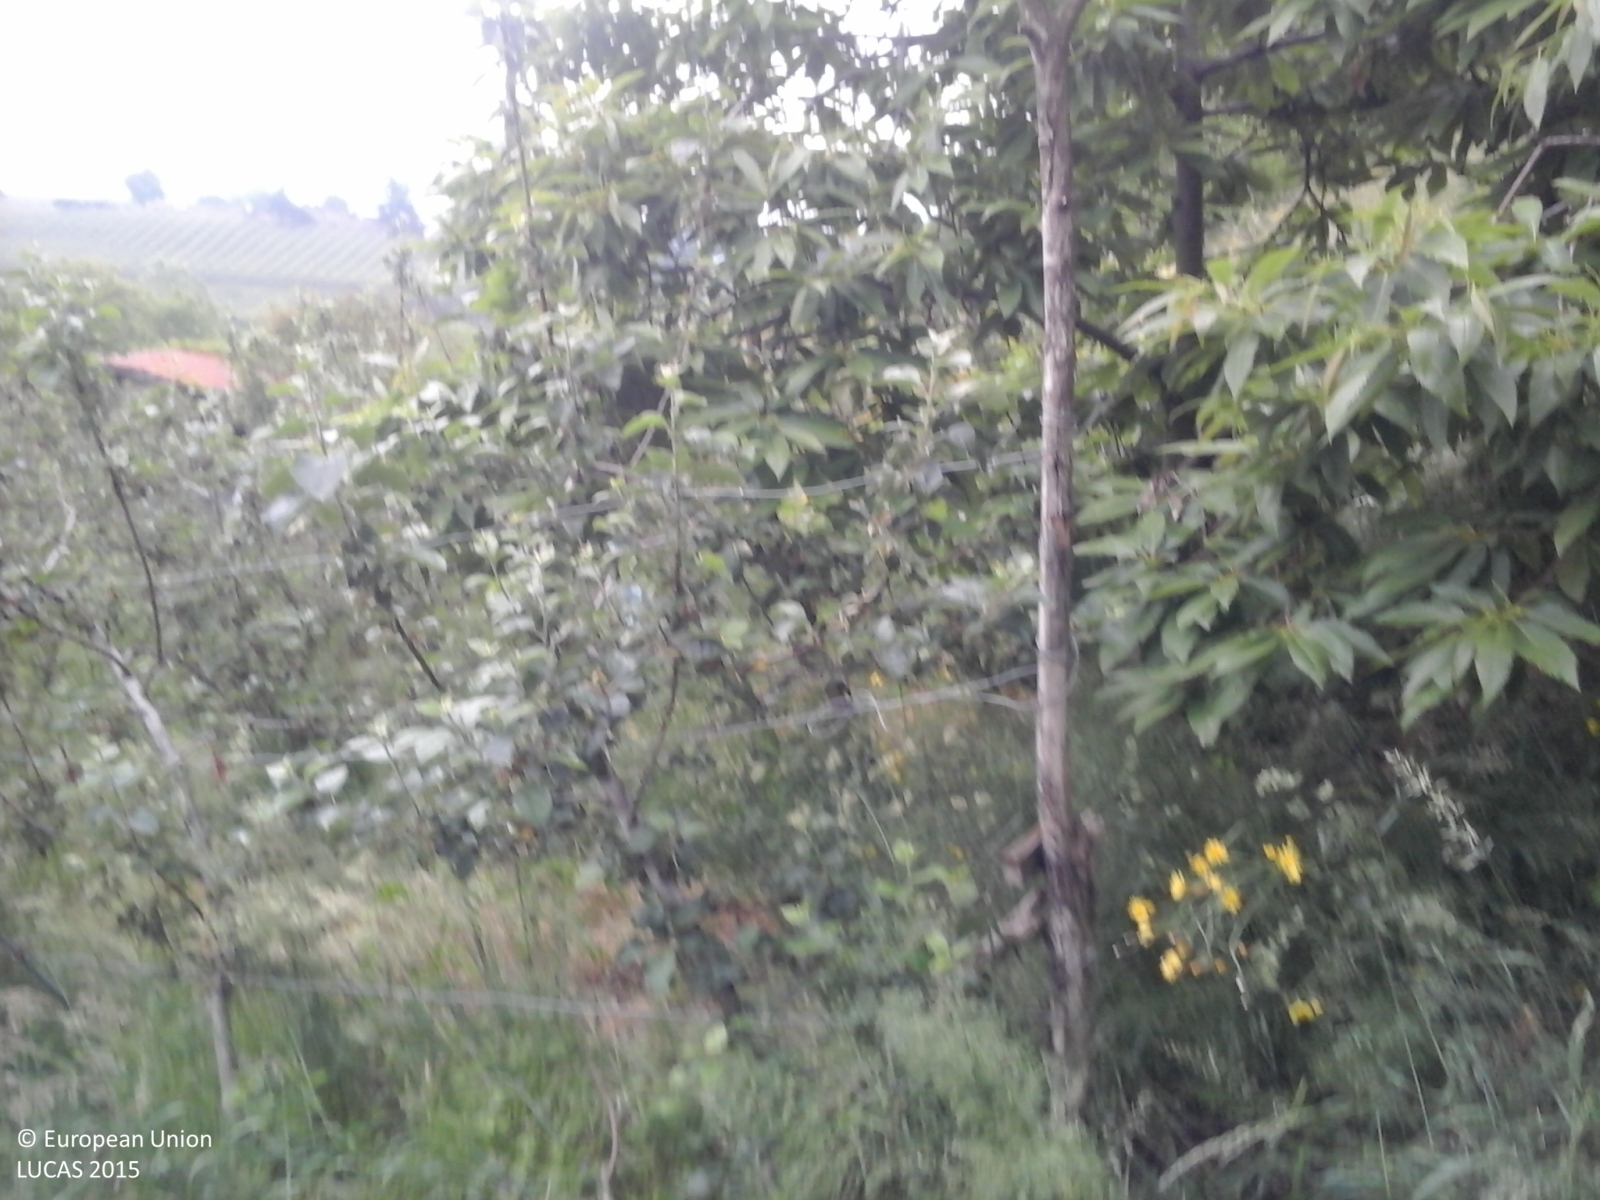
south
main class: Cropland
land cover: Apple fruit
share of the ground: 25 - 50 %
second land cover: Grassland without tree/shrub cover
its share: > 75 %
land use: Agriculture (excluding fallow land and kitchen gardens)
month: May
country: IT
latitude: 45.8244
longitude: 10.9639
